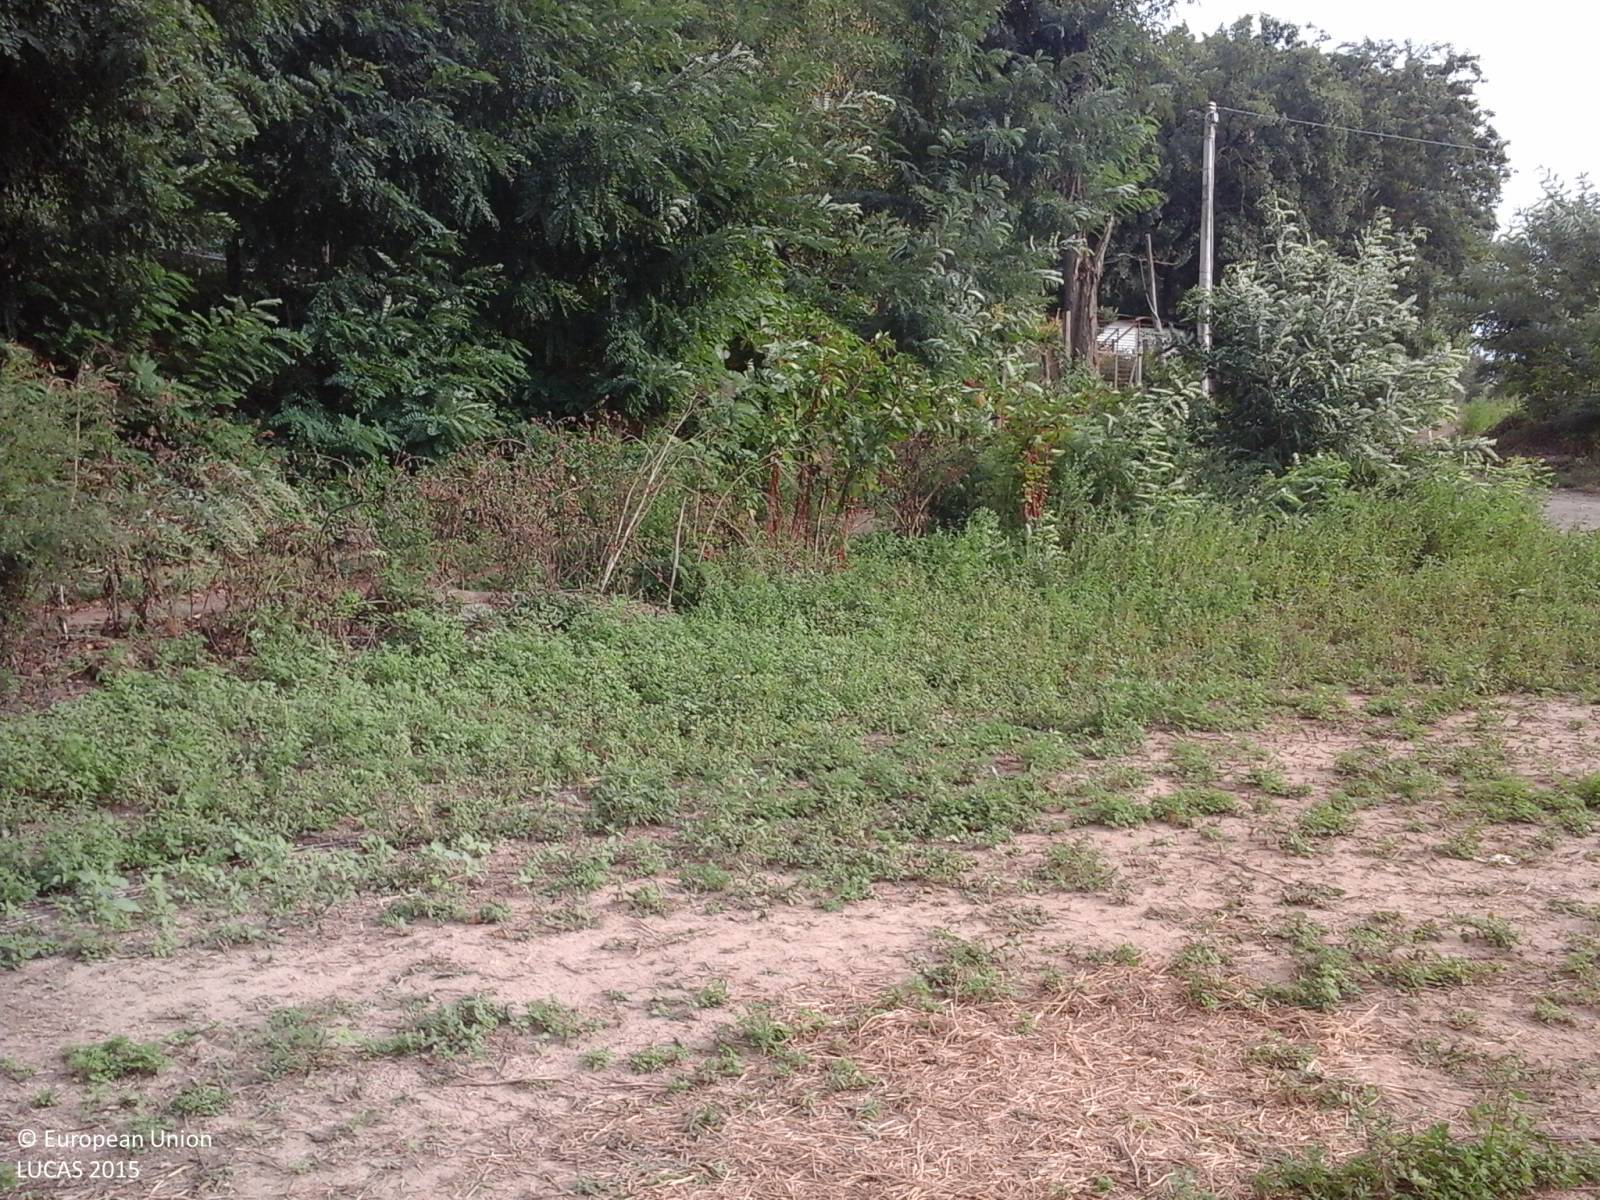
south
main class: Cropland
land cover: Maize
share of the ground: < 10 %
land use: Agriculture (excluding fallow land and kitchen gardens)
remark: Harvested field
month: September
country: IT
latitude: 42.6722
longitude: 11.9095
